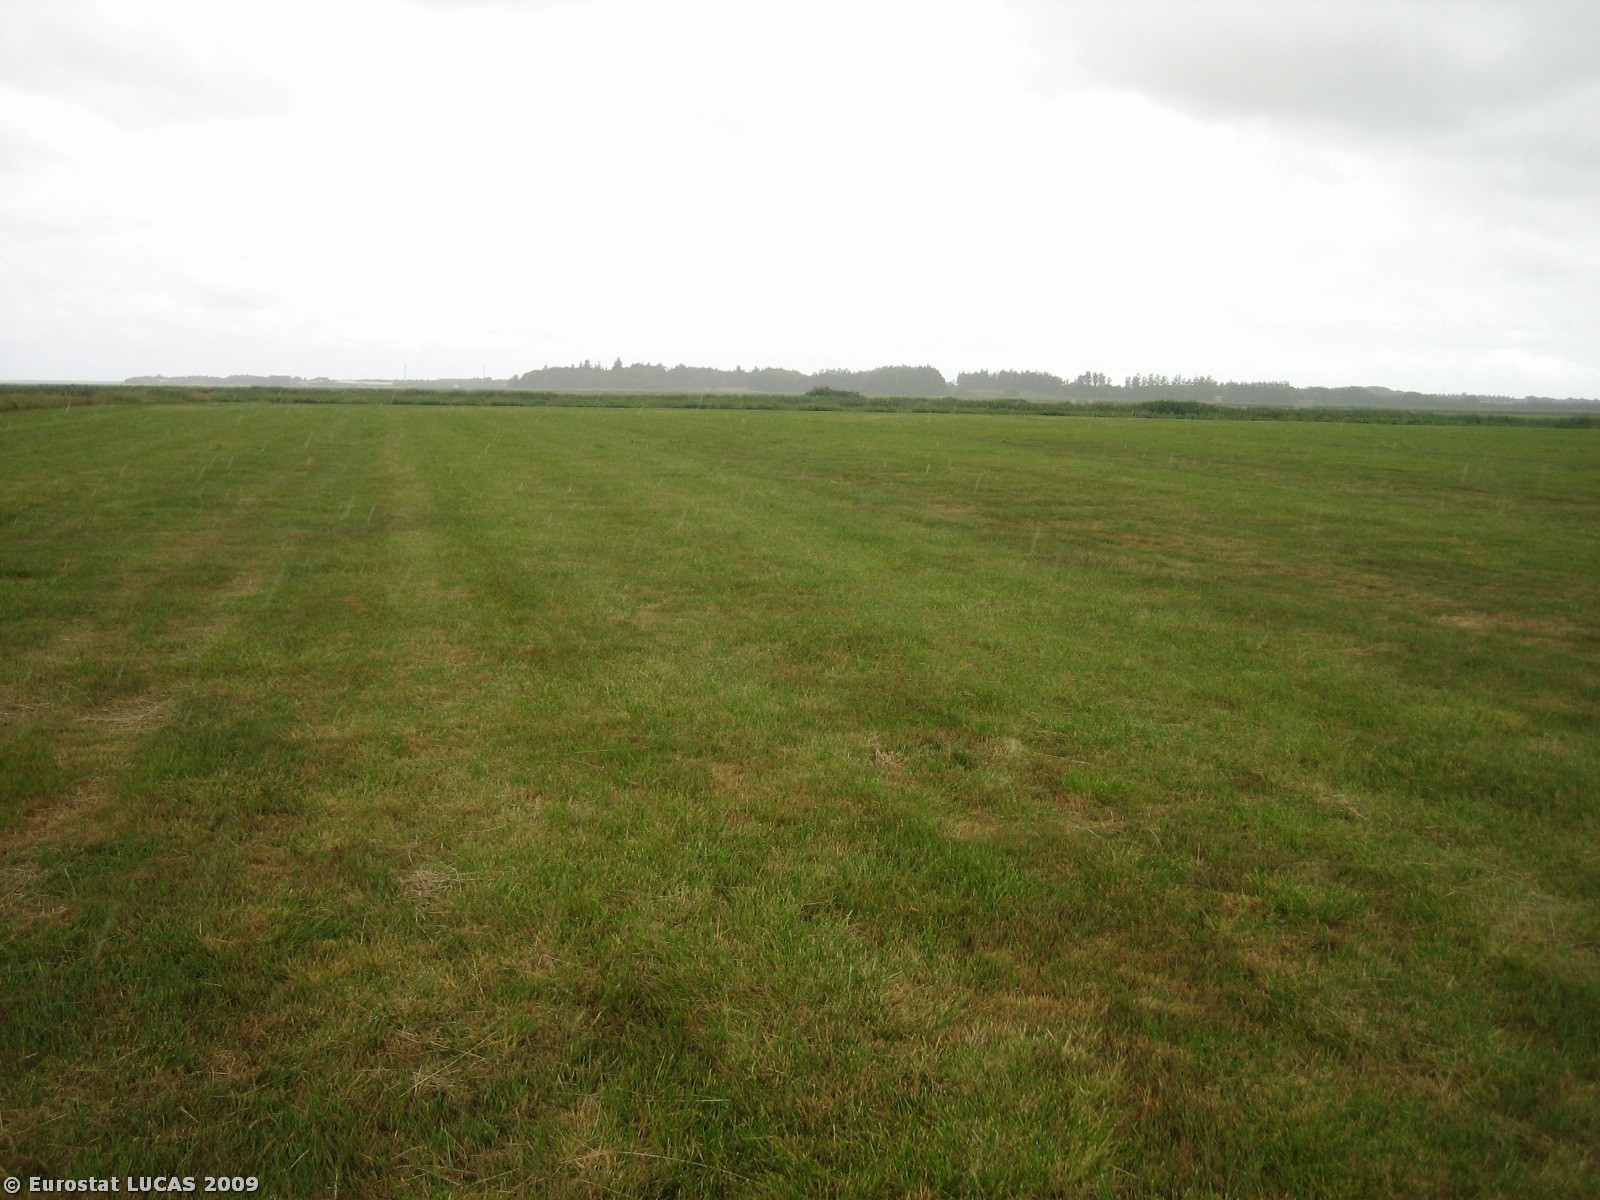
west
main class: Grassland
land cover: Grassland without tree/shrub cover
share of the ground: > 75 %
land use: Agriculture (excluding fallow land and kitchen gardens)
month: July
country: DK
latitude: 55.6020
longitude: 8.3667
